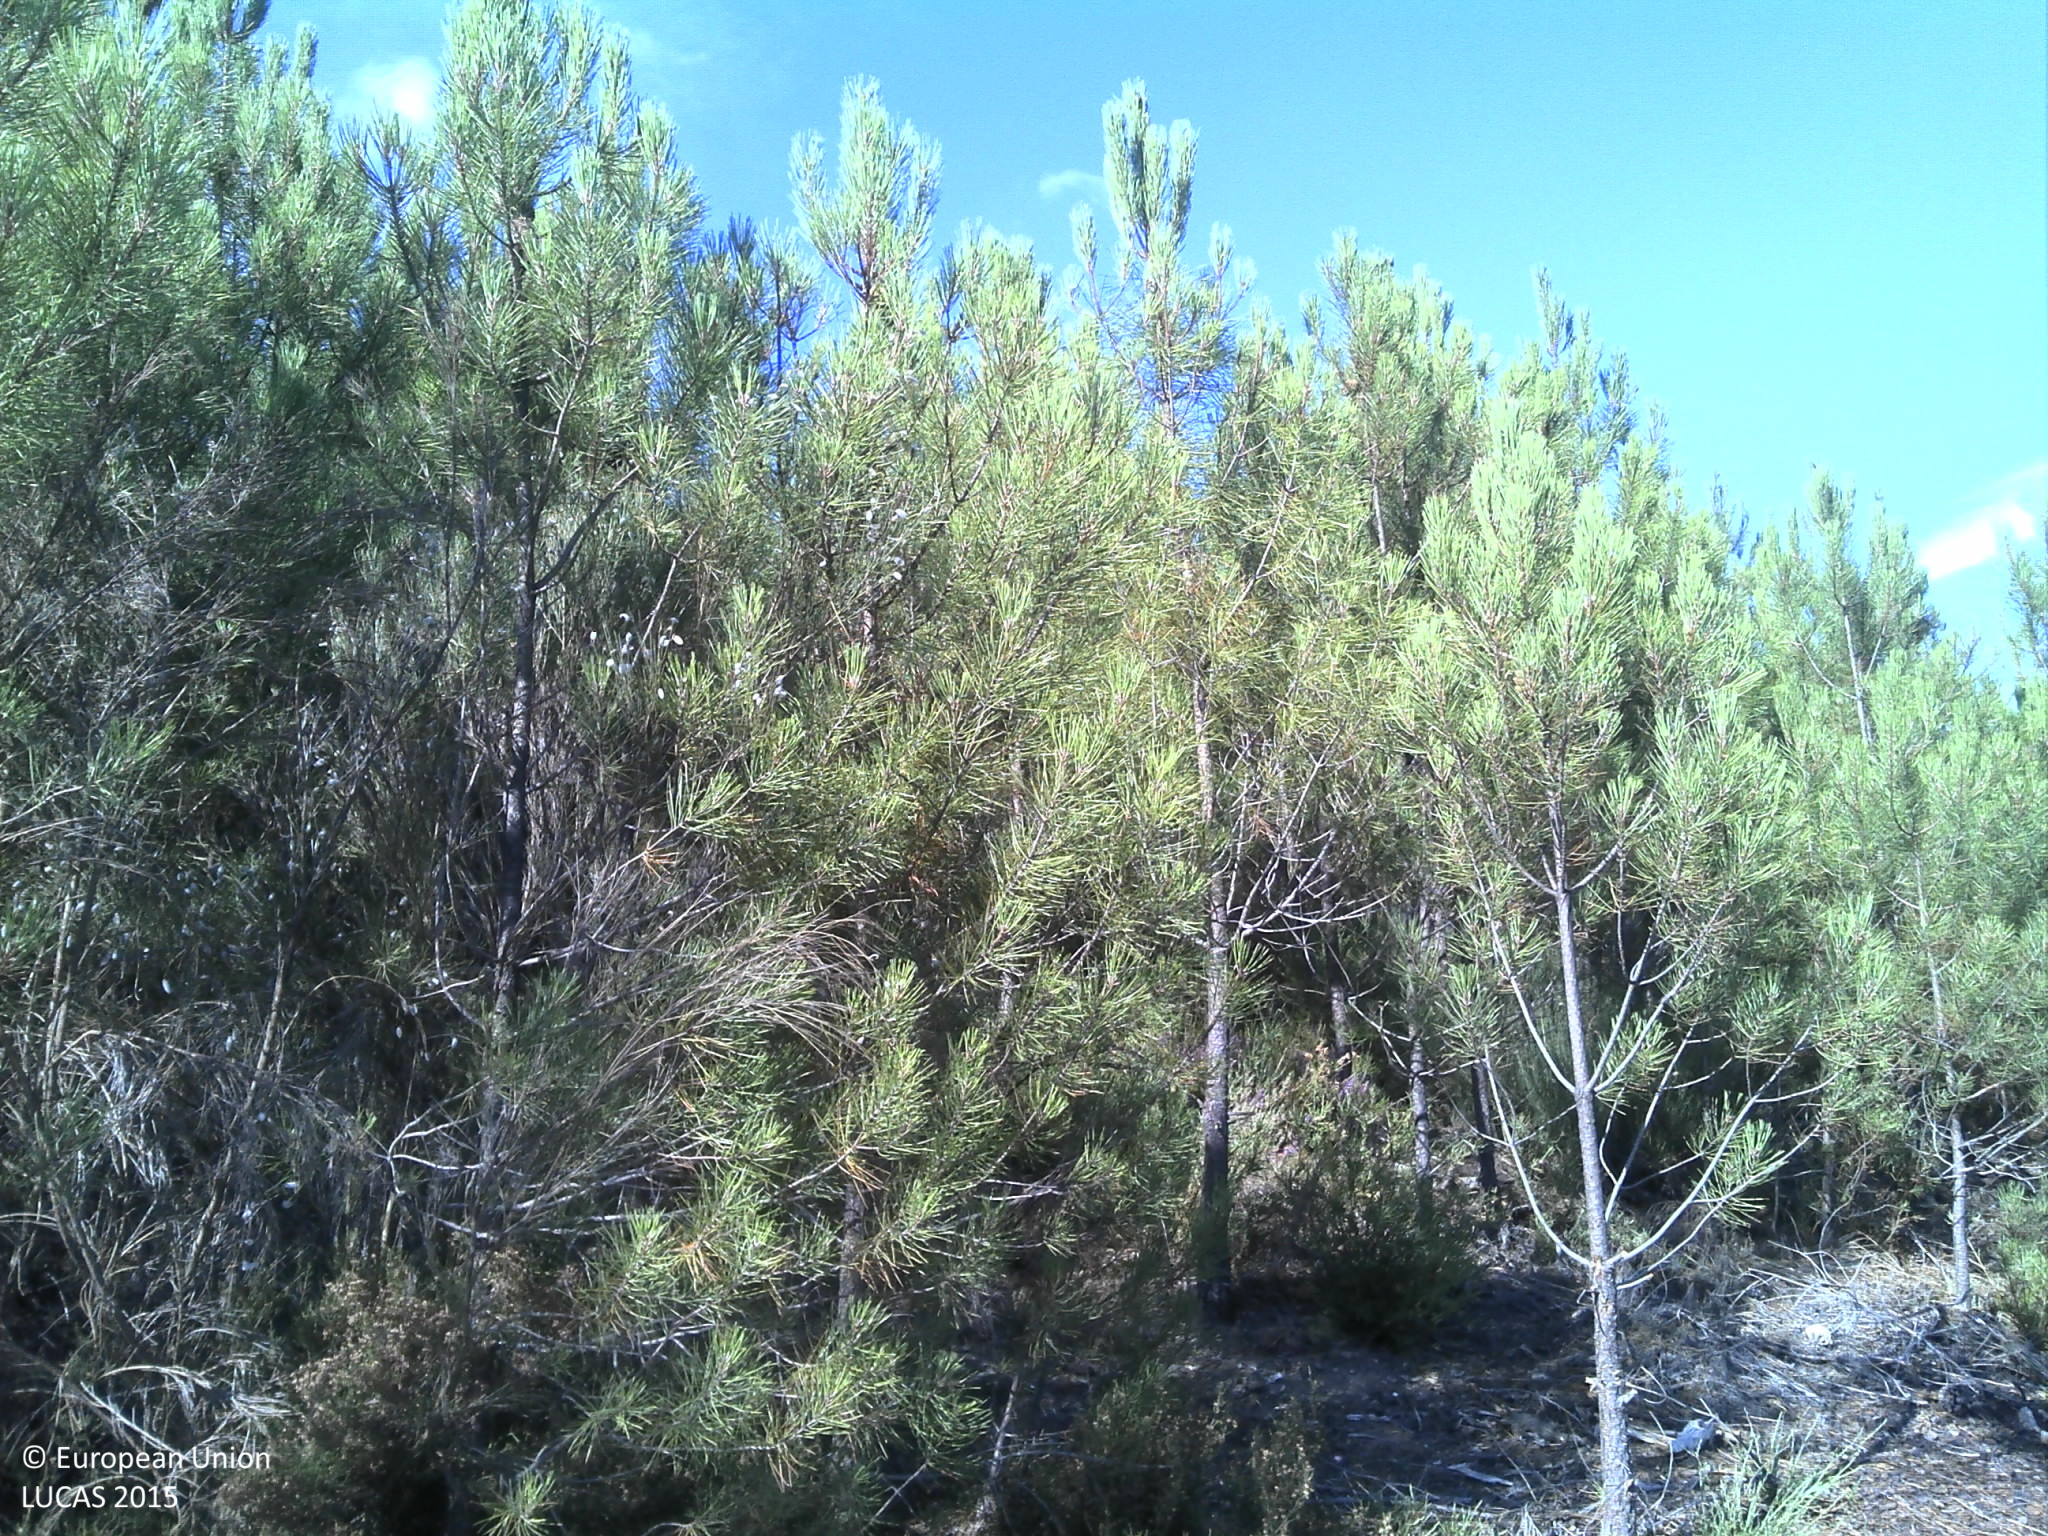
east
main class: Shrubland
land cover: Shrubland without tree cover
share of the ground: > 75 %
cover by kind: shrubs 90 %, unconsolidated bare surface 5 %
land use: Abandoned areas
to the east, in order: Shrubland without tree cover; Tracks; Pine dominated coniferous woodland; Spontaneously vegetated surfaces; Olive groves; Tracks; Shrubland with sparse tree cover
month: July
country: PT
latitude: 40.1309
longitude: -7.8460
